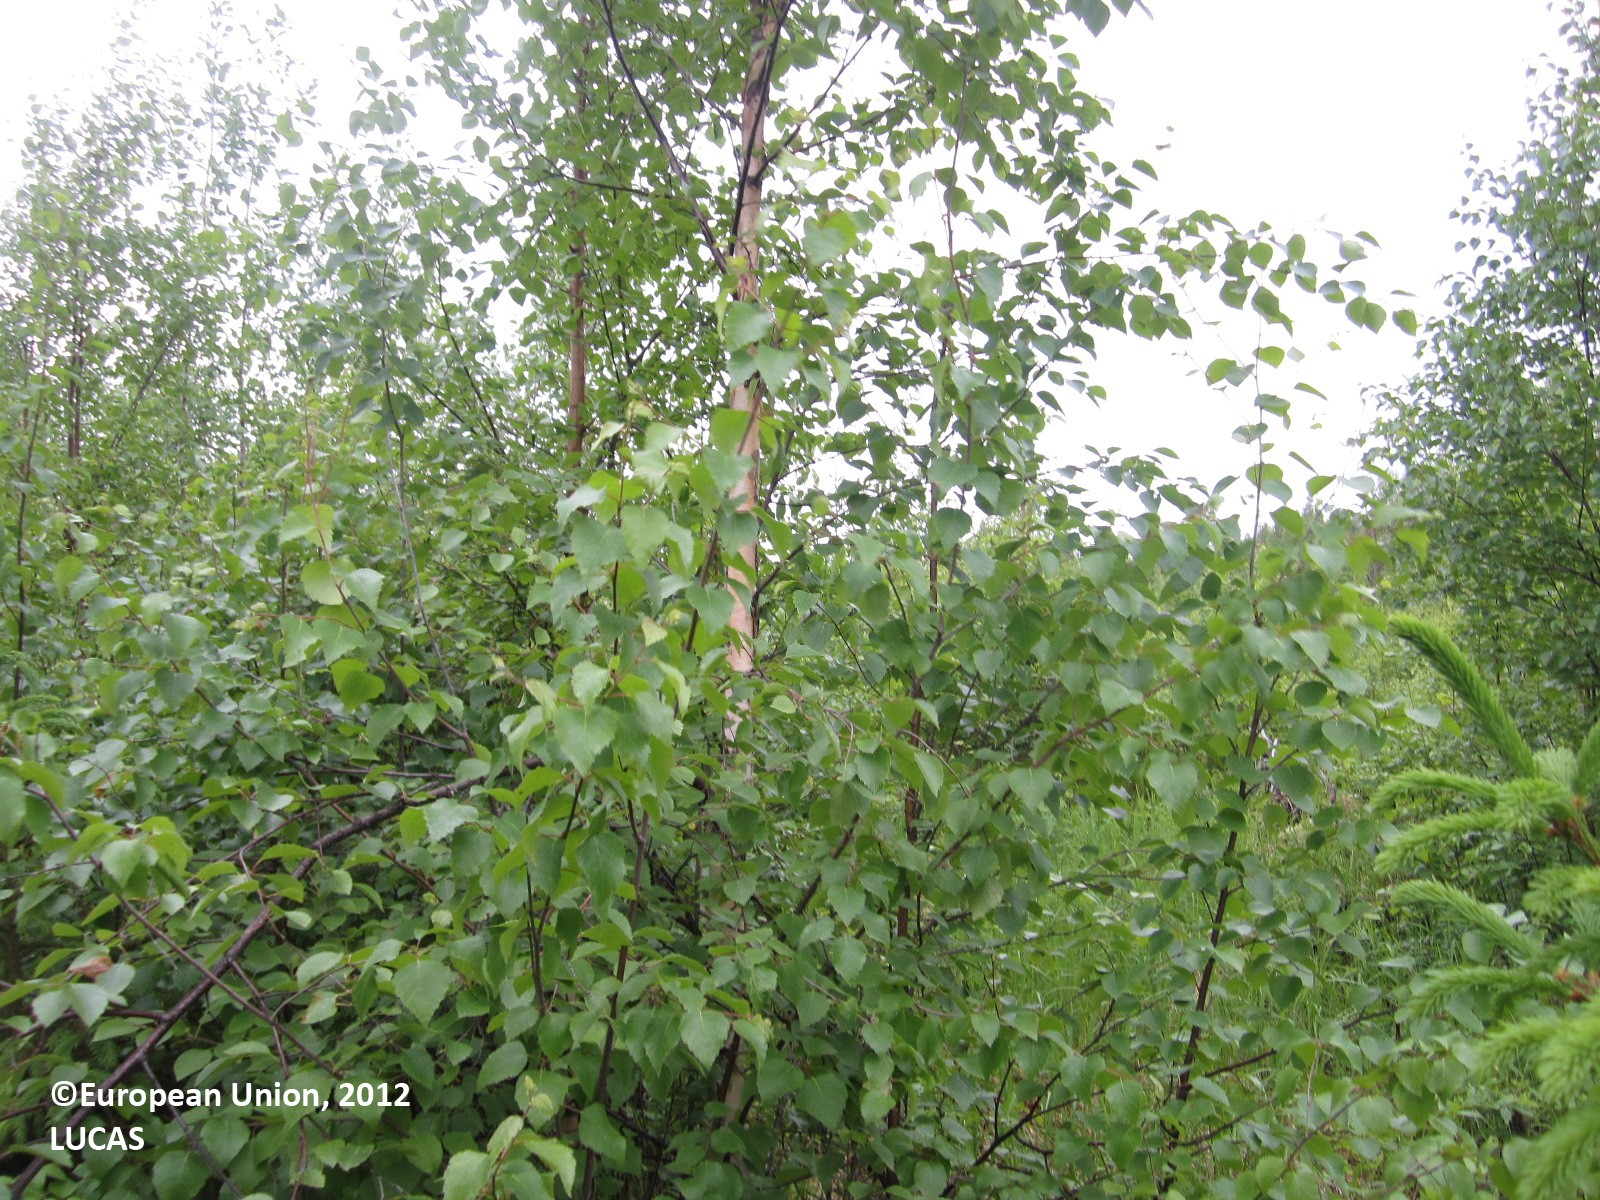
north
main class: Woodland
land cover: Broadleaved woodland
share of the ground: > 75 %
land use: Forestry
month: June
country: FI
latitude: 64.3097
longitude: 29.8077
